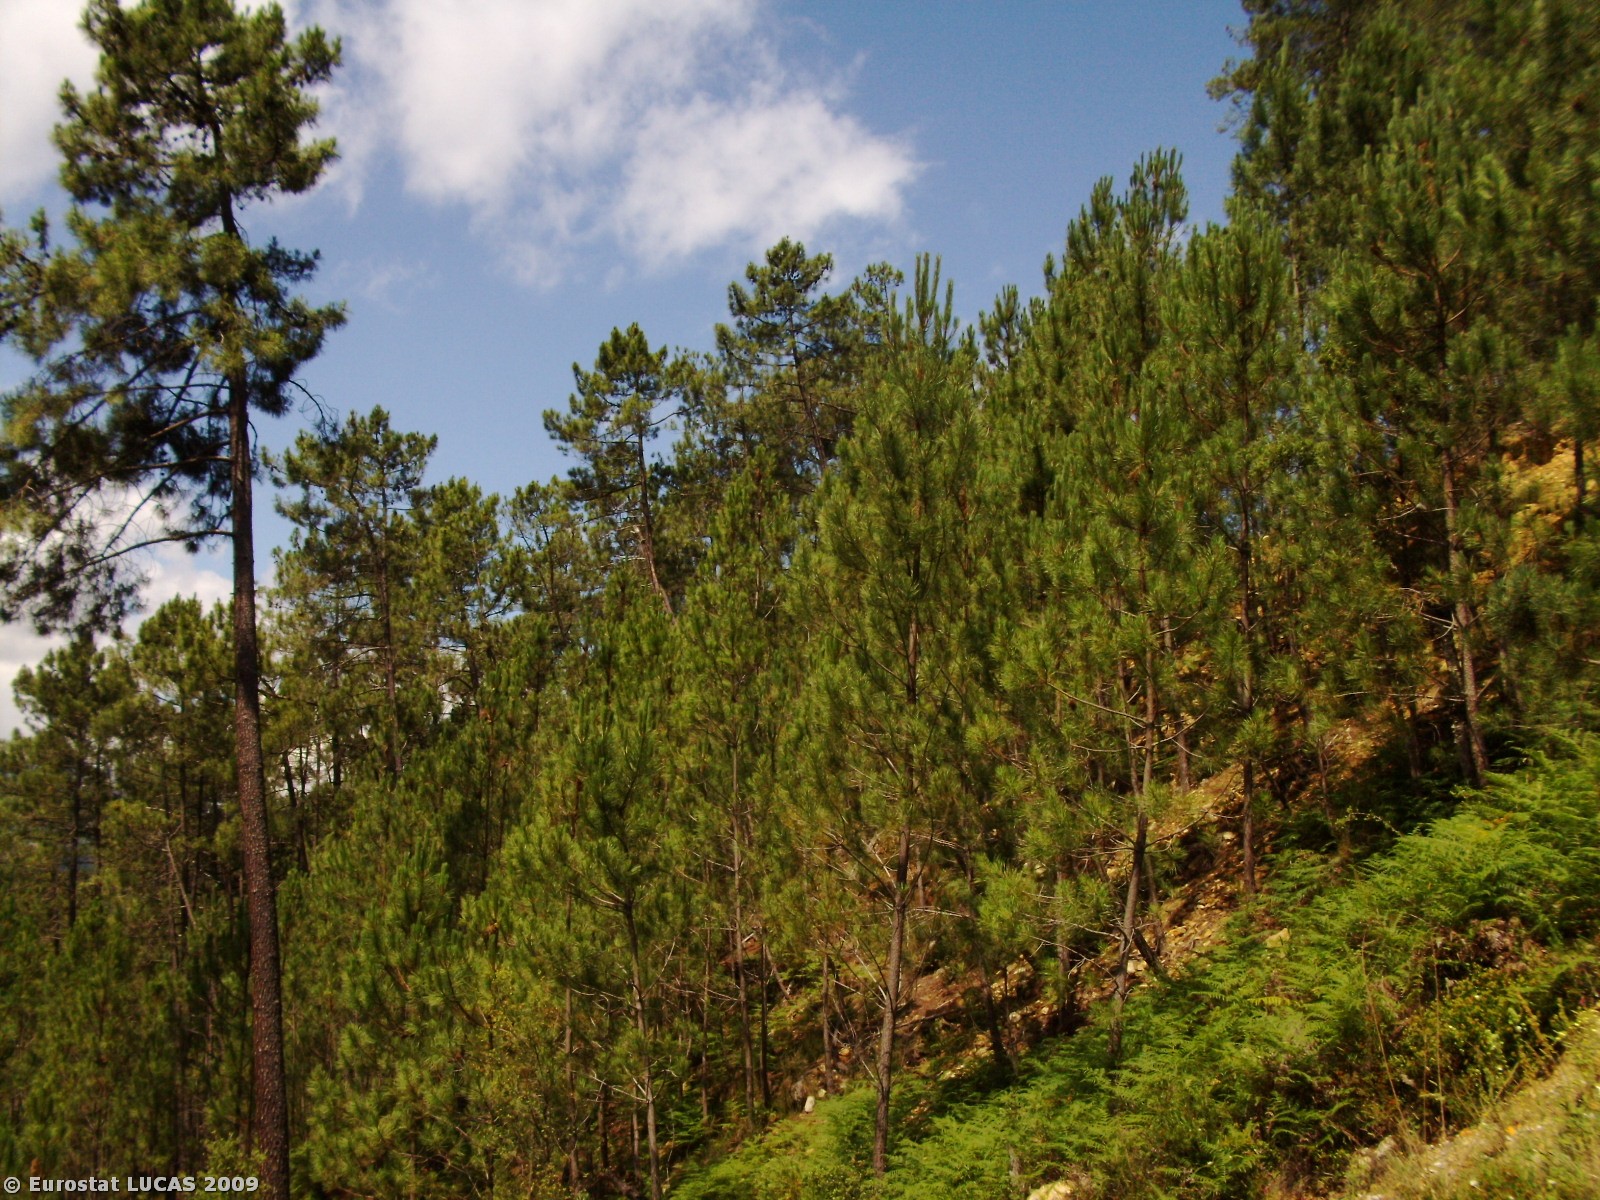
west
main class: Woodland
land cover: Coniferous woodland
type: coniferous forest of the mediterranean region
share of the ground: 50 - 75 %
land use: Forestry
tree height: > 5 m
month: June
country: PT
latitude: 40.3183
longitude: -7.7305
